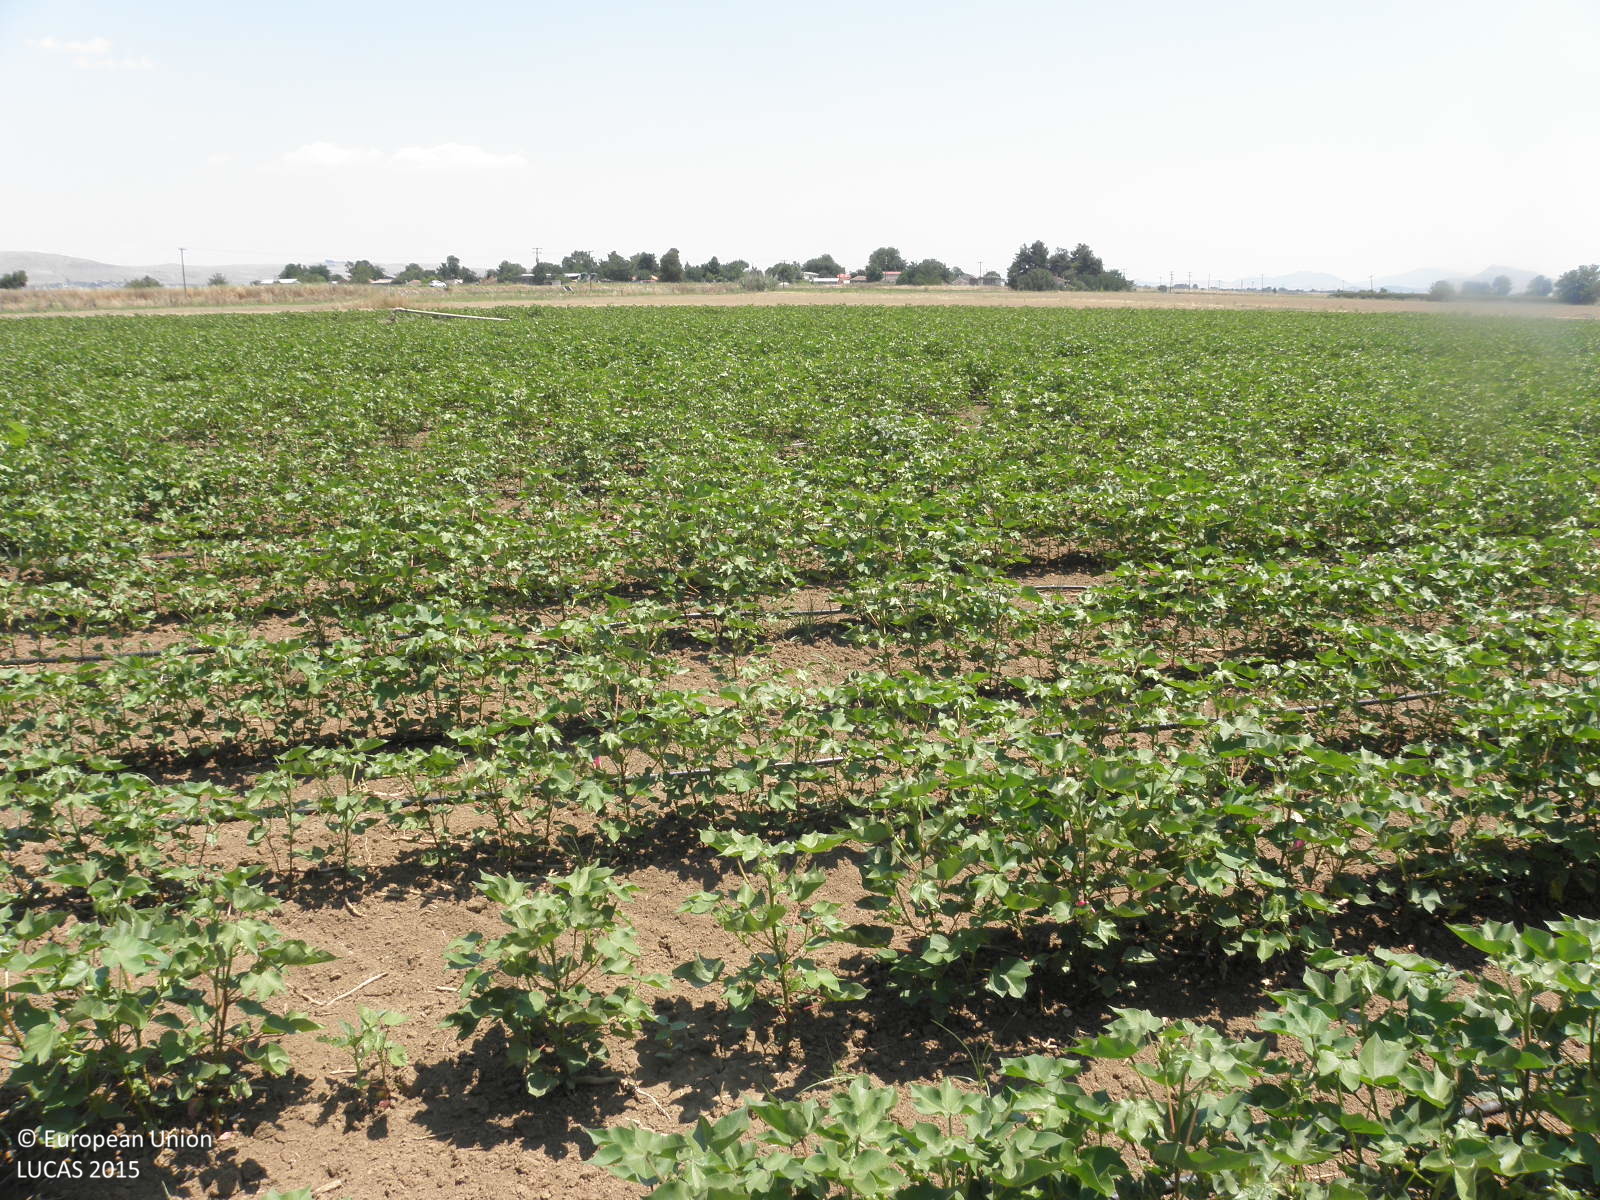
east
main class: Cropland
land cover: Cotton
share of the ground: > 75 %
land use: Agriculture (excluding fallow land and kitchen gardens)
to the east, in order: Cotton; Durum wheat; Shruby margins; Ditches and canals; Shruby margins; Cotton
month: July
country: GR
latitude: 39.3623
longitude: 22.2994
